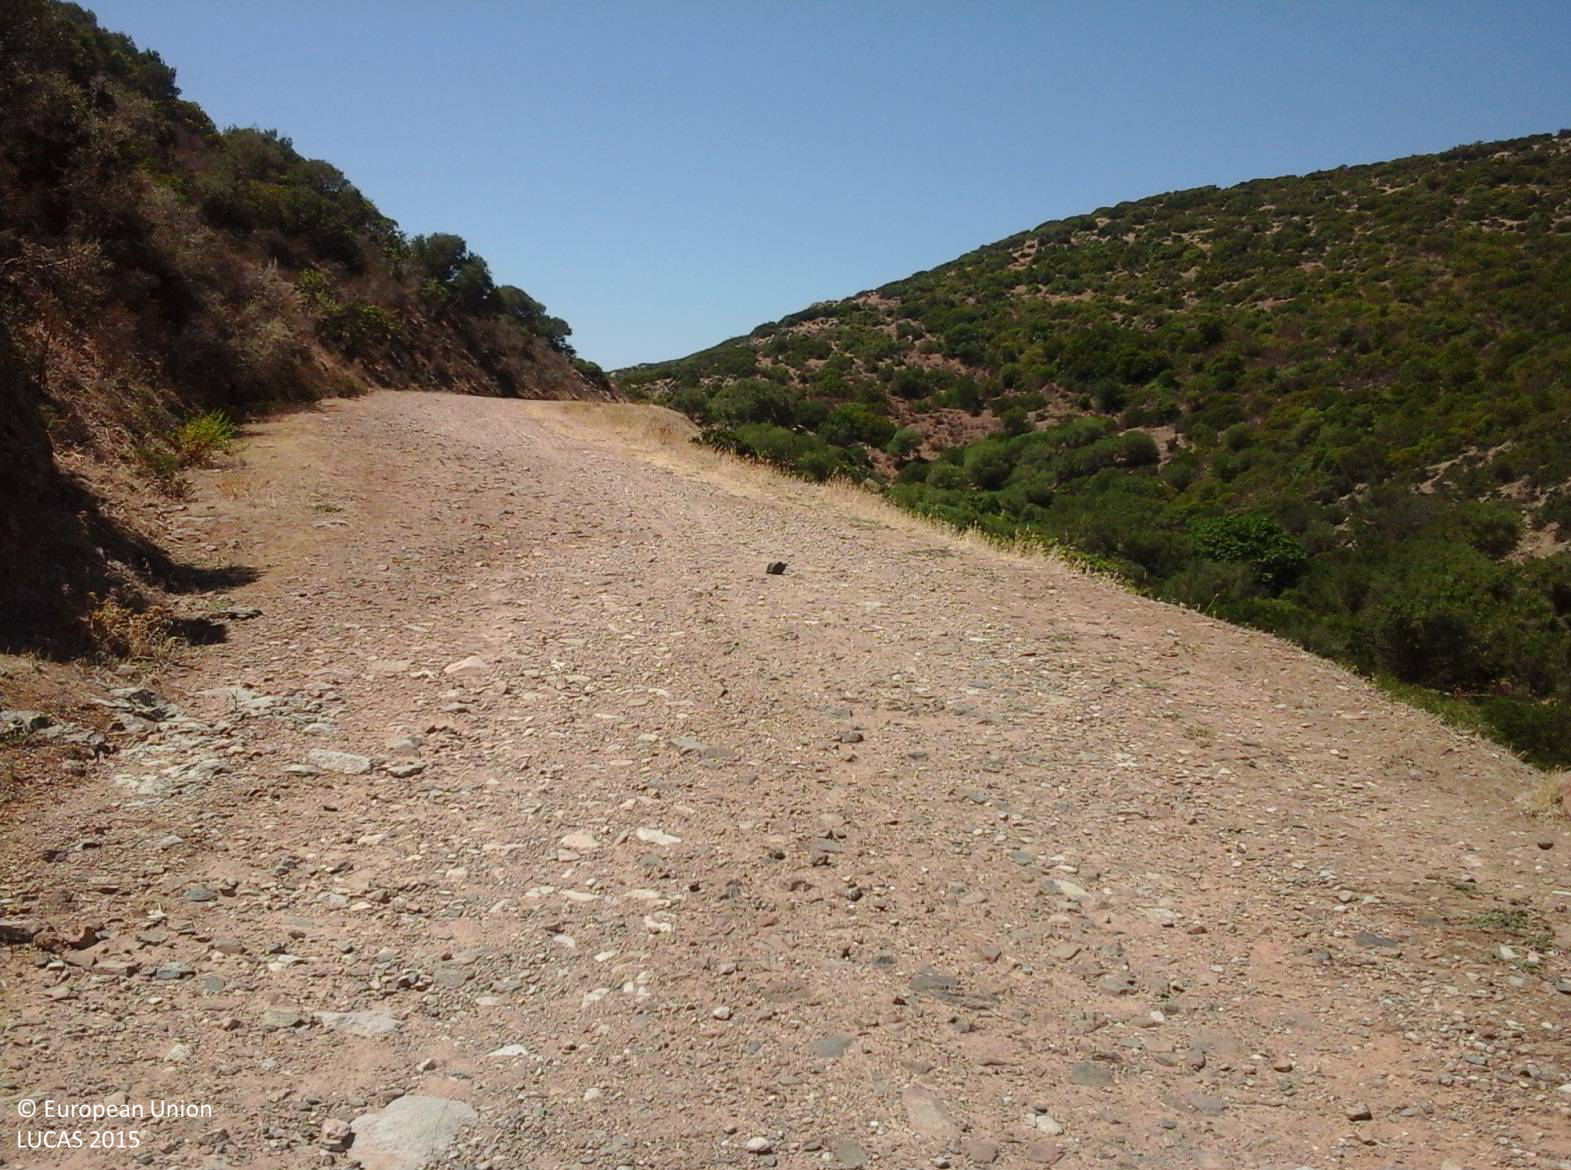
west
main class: Shrubland
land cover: Shrubland without tree cover
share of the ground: > 75 %
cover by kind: shrubs 100 %
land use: Semi-natural and natural areas not in use
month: August
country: IT
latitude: 39.4129
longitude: 9.2034
